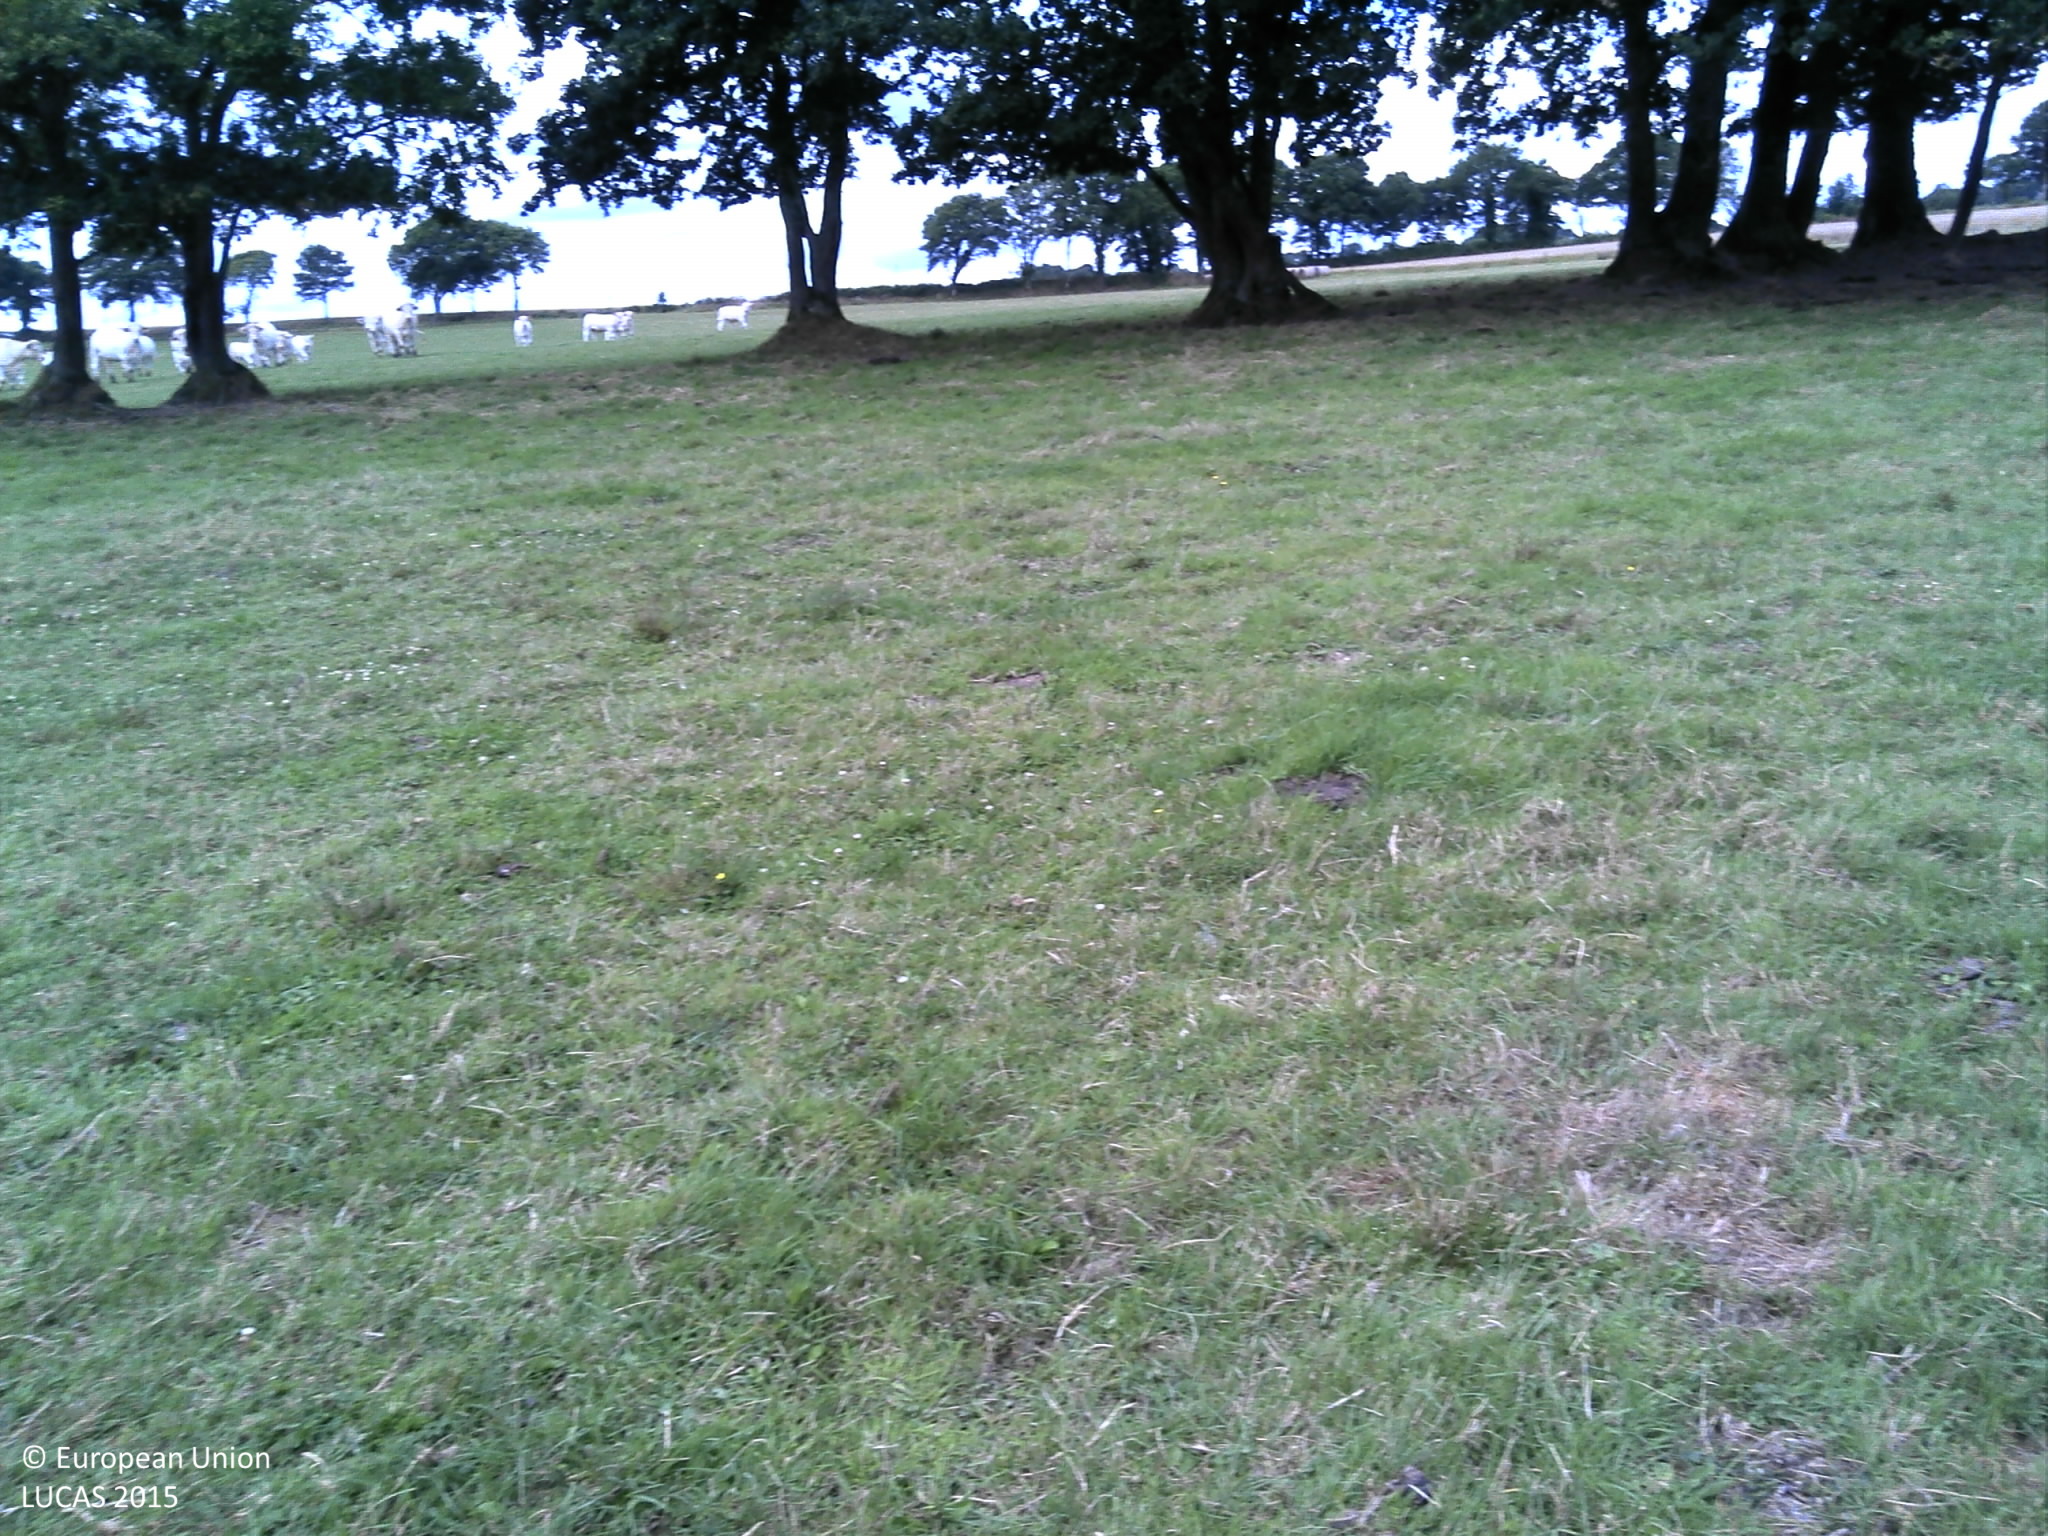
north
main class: Grassland
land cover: Grassland without tree/shrub cover
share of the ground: > 75 %
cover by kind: herbaceous plants 100 %
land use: Agriculture (excluding fallow land and kitchen gardens)
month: July
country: FR
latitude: 48.2784
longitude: -3.6777
